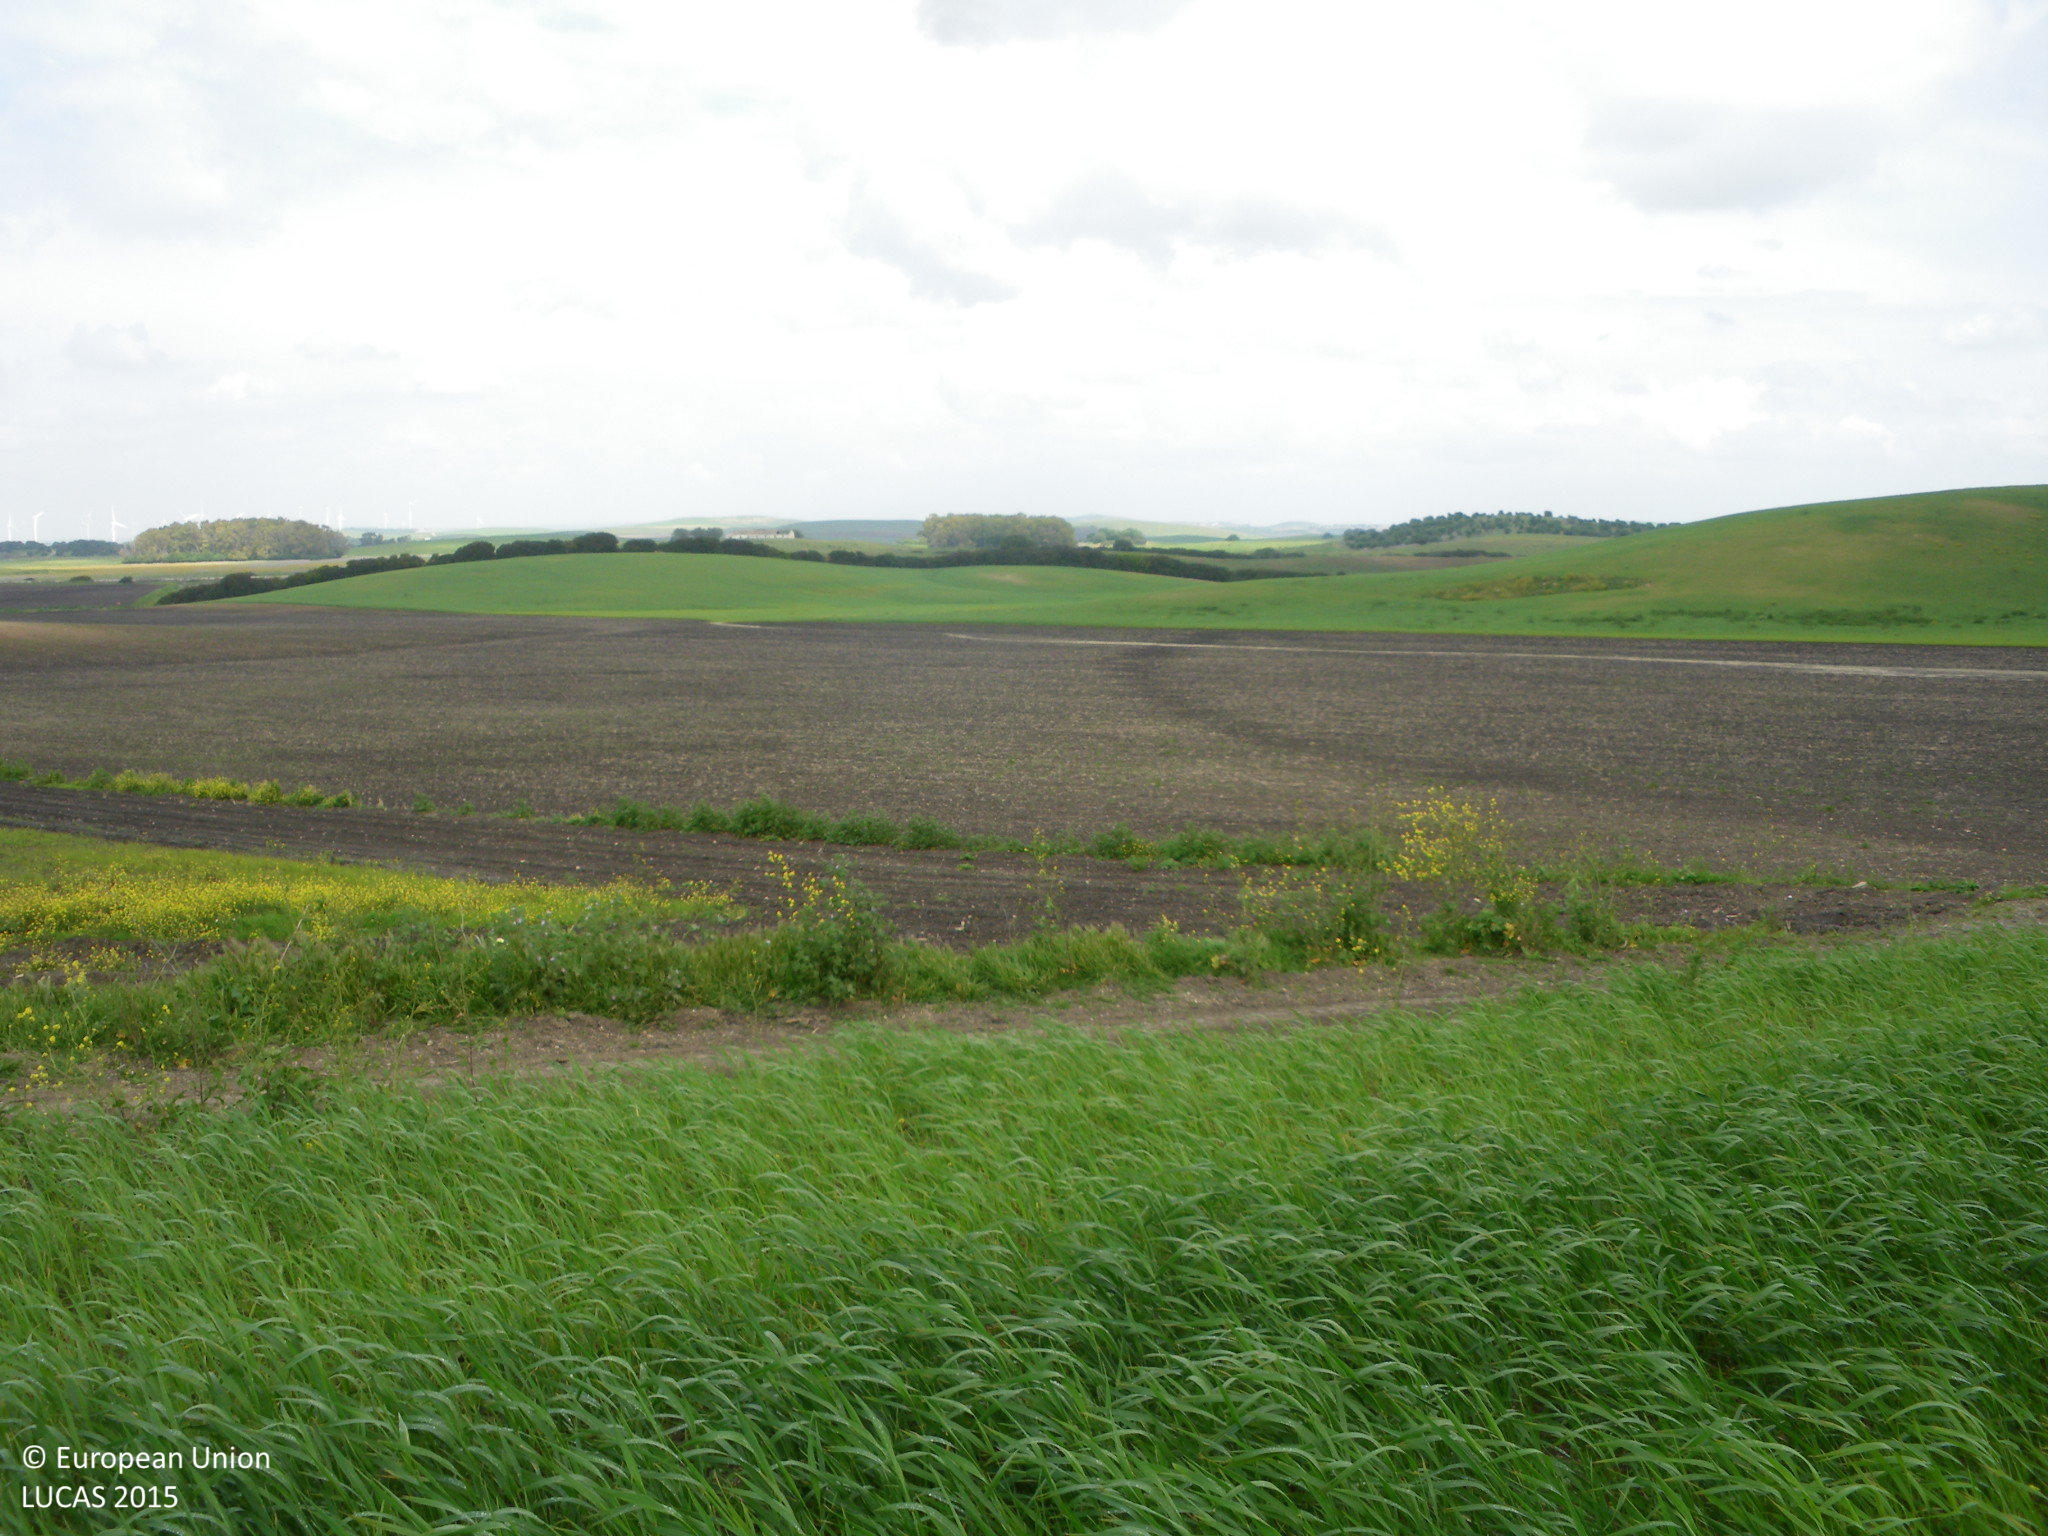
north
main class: Cropland
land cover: Durum wheat
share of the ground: > 75 %
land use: Agriculture (excluding fallow land and kitchen gardens)
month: April
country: ES
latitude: 36.5186
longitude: -5.9639
